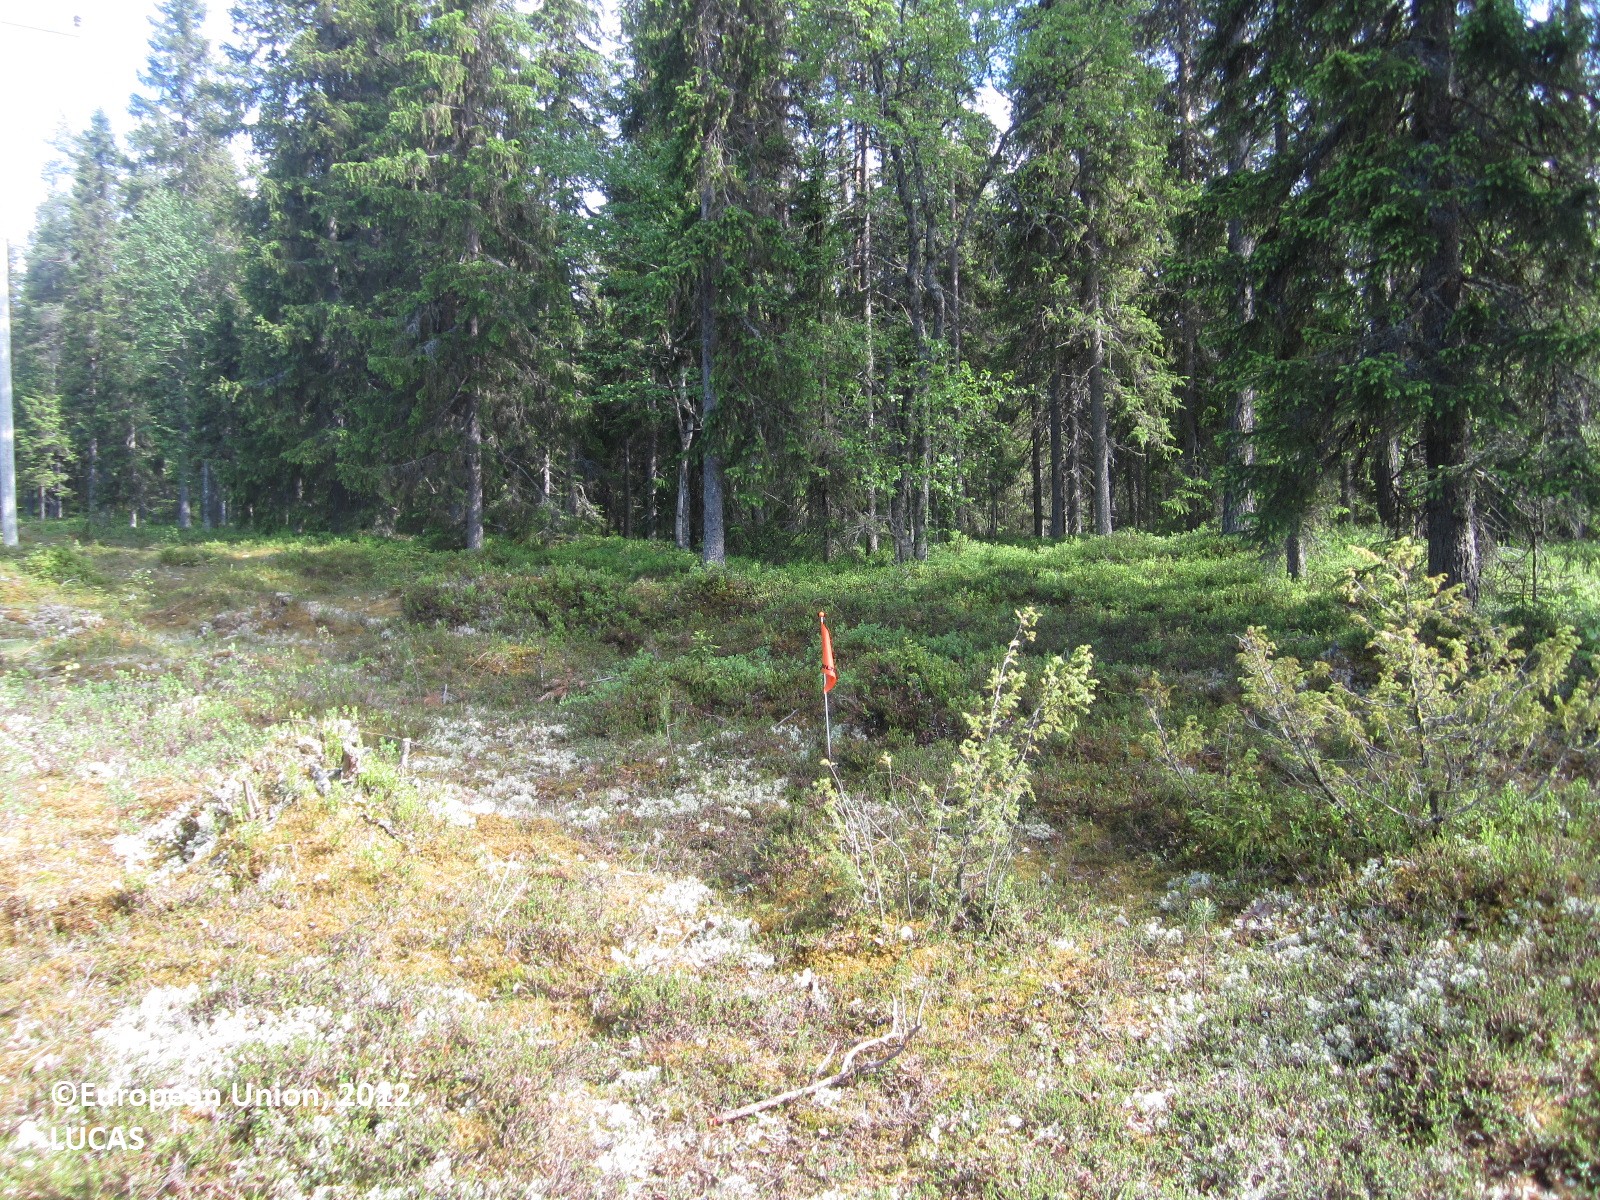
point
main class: Shrubland
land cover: Shrubland without tree cover
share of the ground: 50 - 75 %
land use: Energy production
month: June
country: FI
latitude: 64.6412
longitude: 30.0077
